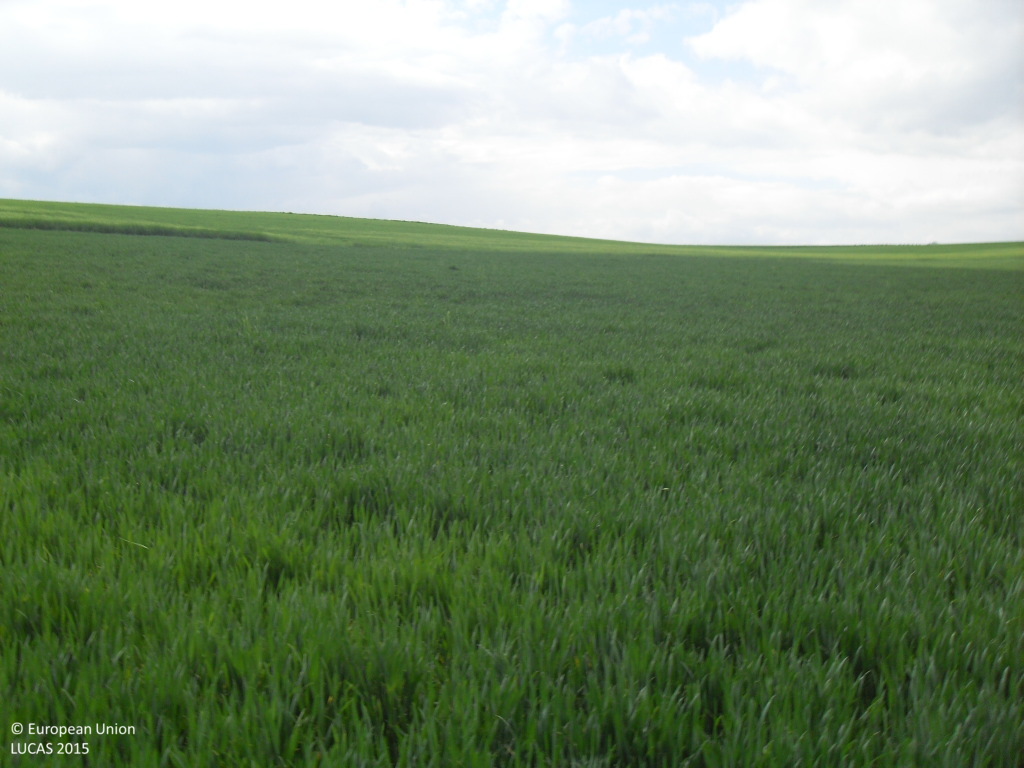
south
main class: Cropland
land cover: Common wheat
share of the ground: > 75 %
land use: Agriculture (excluding fallow land and kitchen gardens)
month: April
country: ES
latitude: 40.8009
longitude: -5.3231
